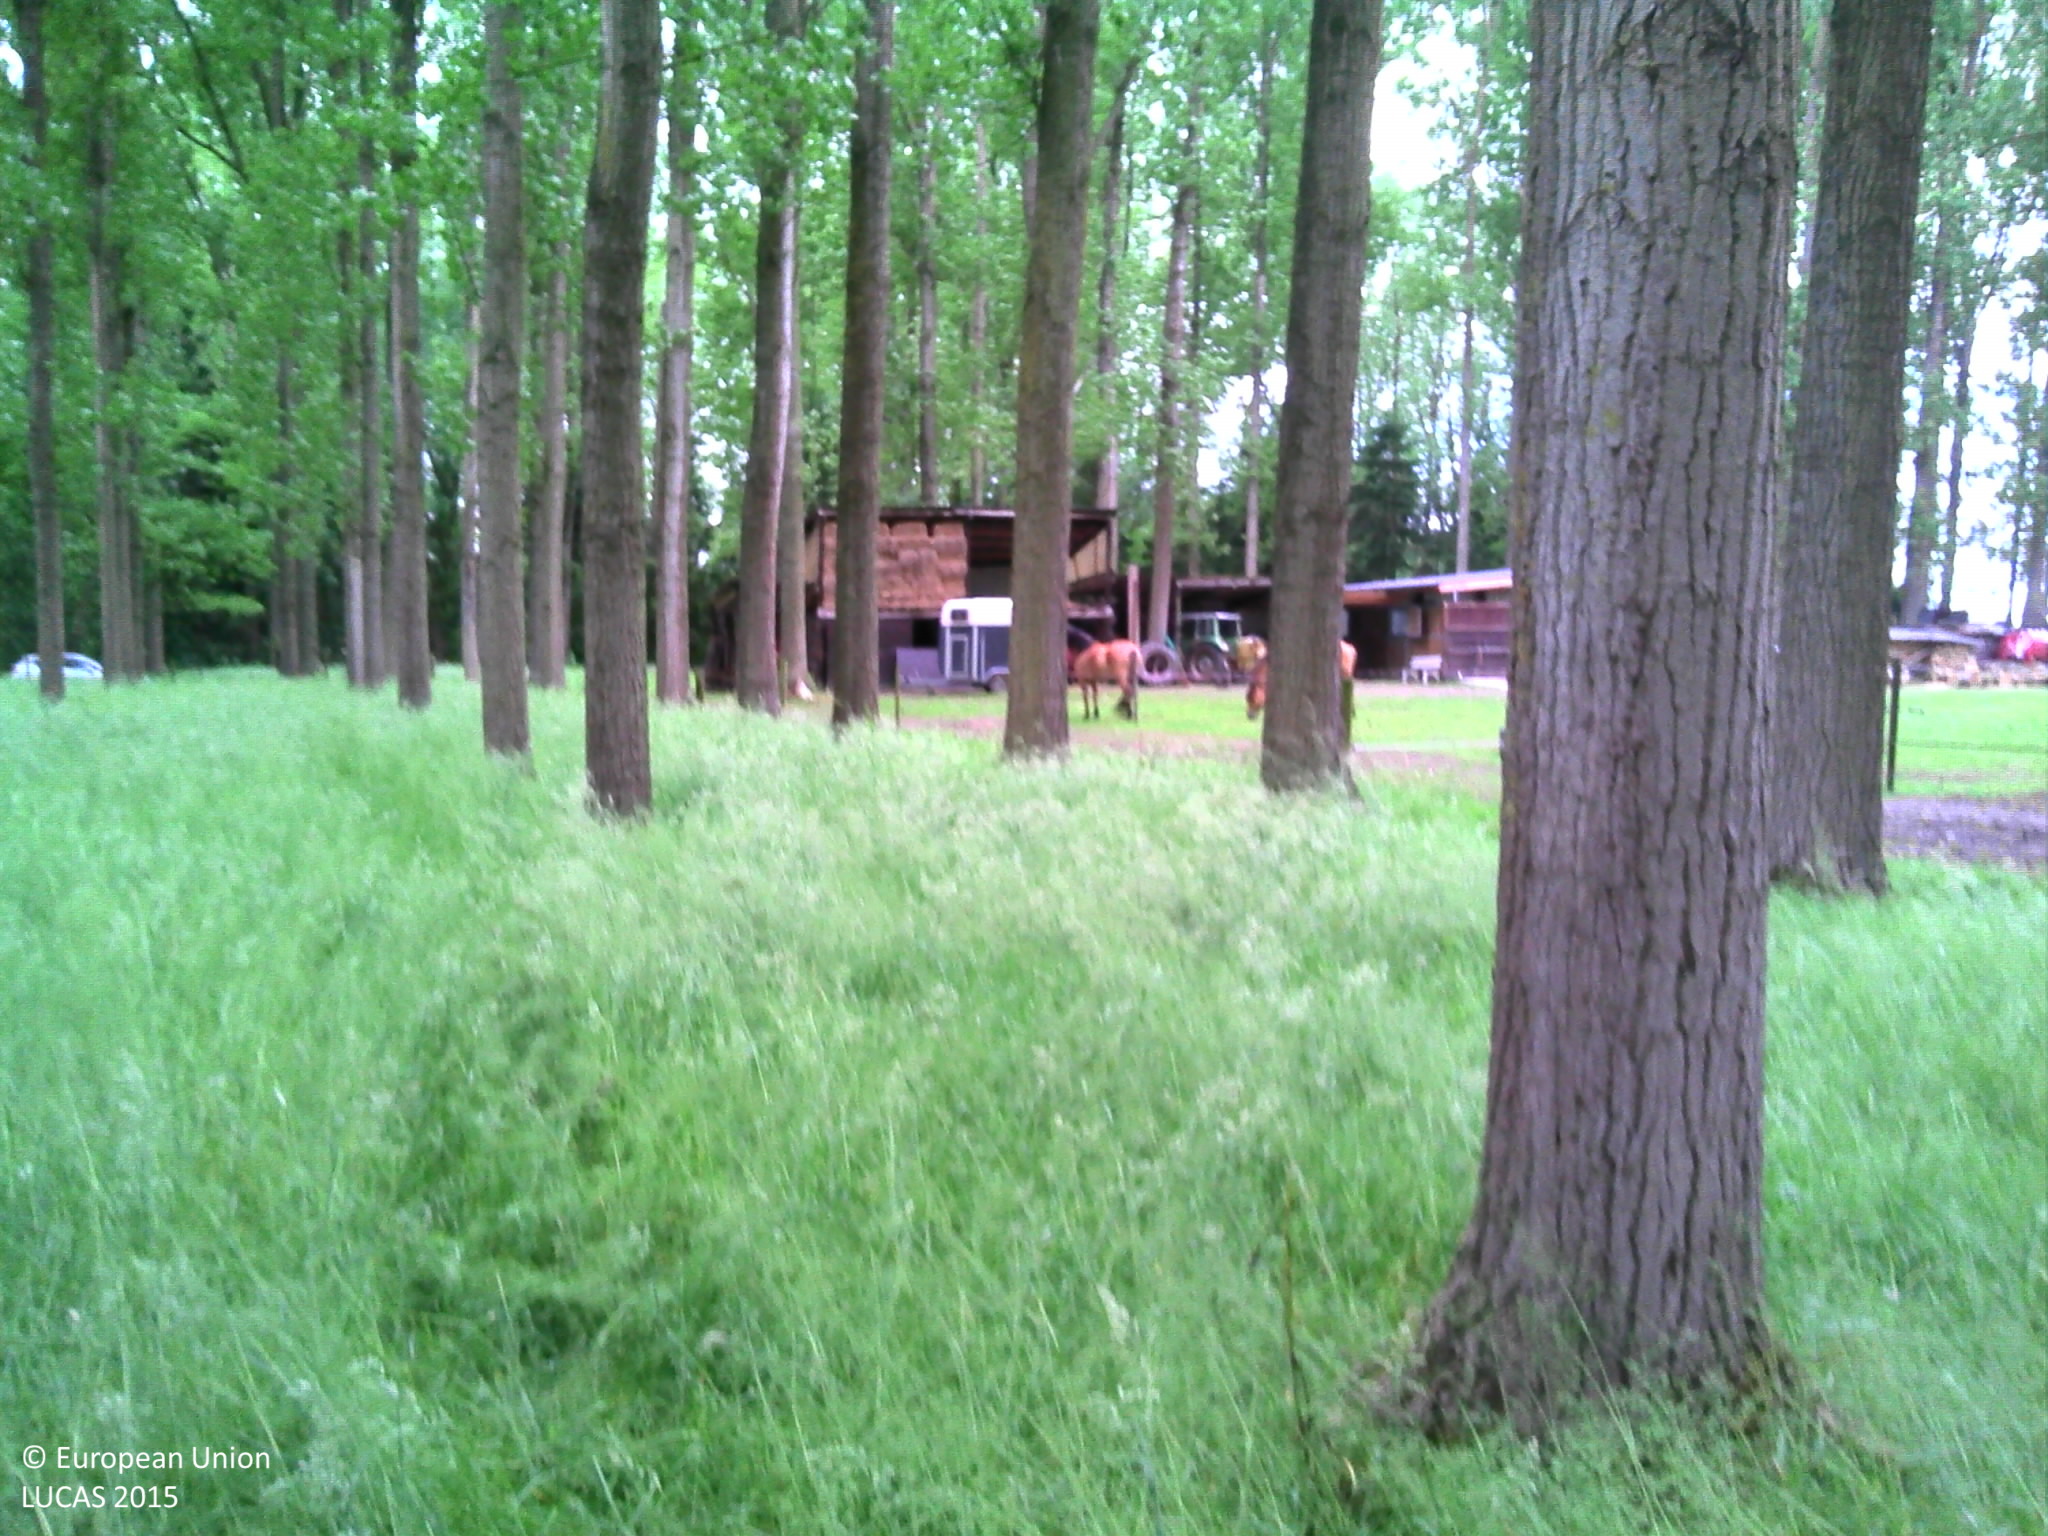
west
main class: Woodland
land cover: Broadleaved woodland
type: exotic forest
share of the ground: > 75 %
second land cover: Grassland without tree/shrub cover
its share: > 75 %
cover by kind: broadleaved forest trees 75 %, herbaceous plants 25 %
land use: Forestry
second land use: Agriculture (excluding fallow land and kitchen gardens)
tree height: > 5 m
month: June
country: BE
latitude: 50.9817
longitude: 3.9974
